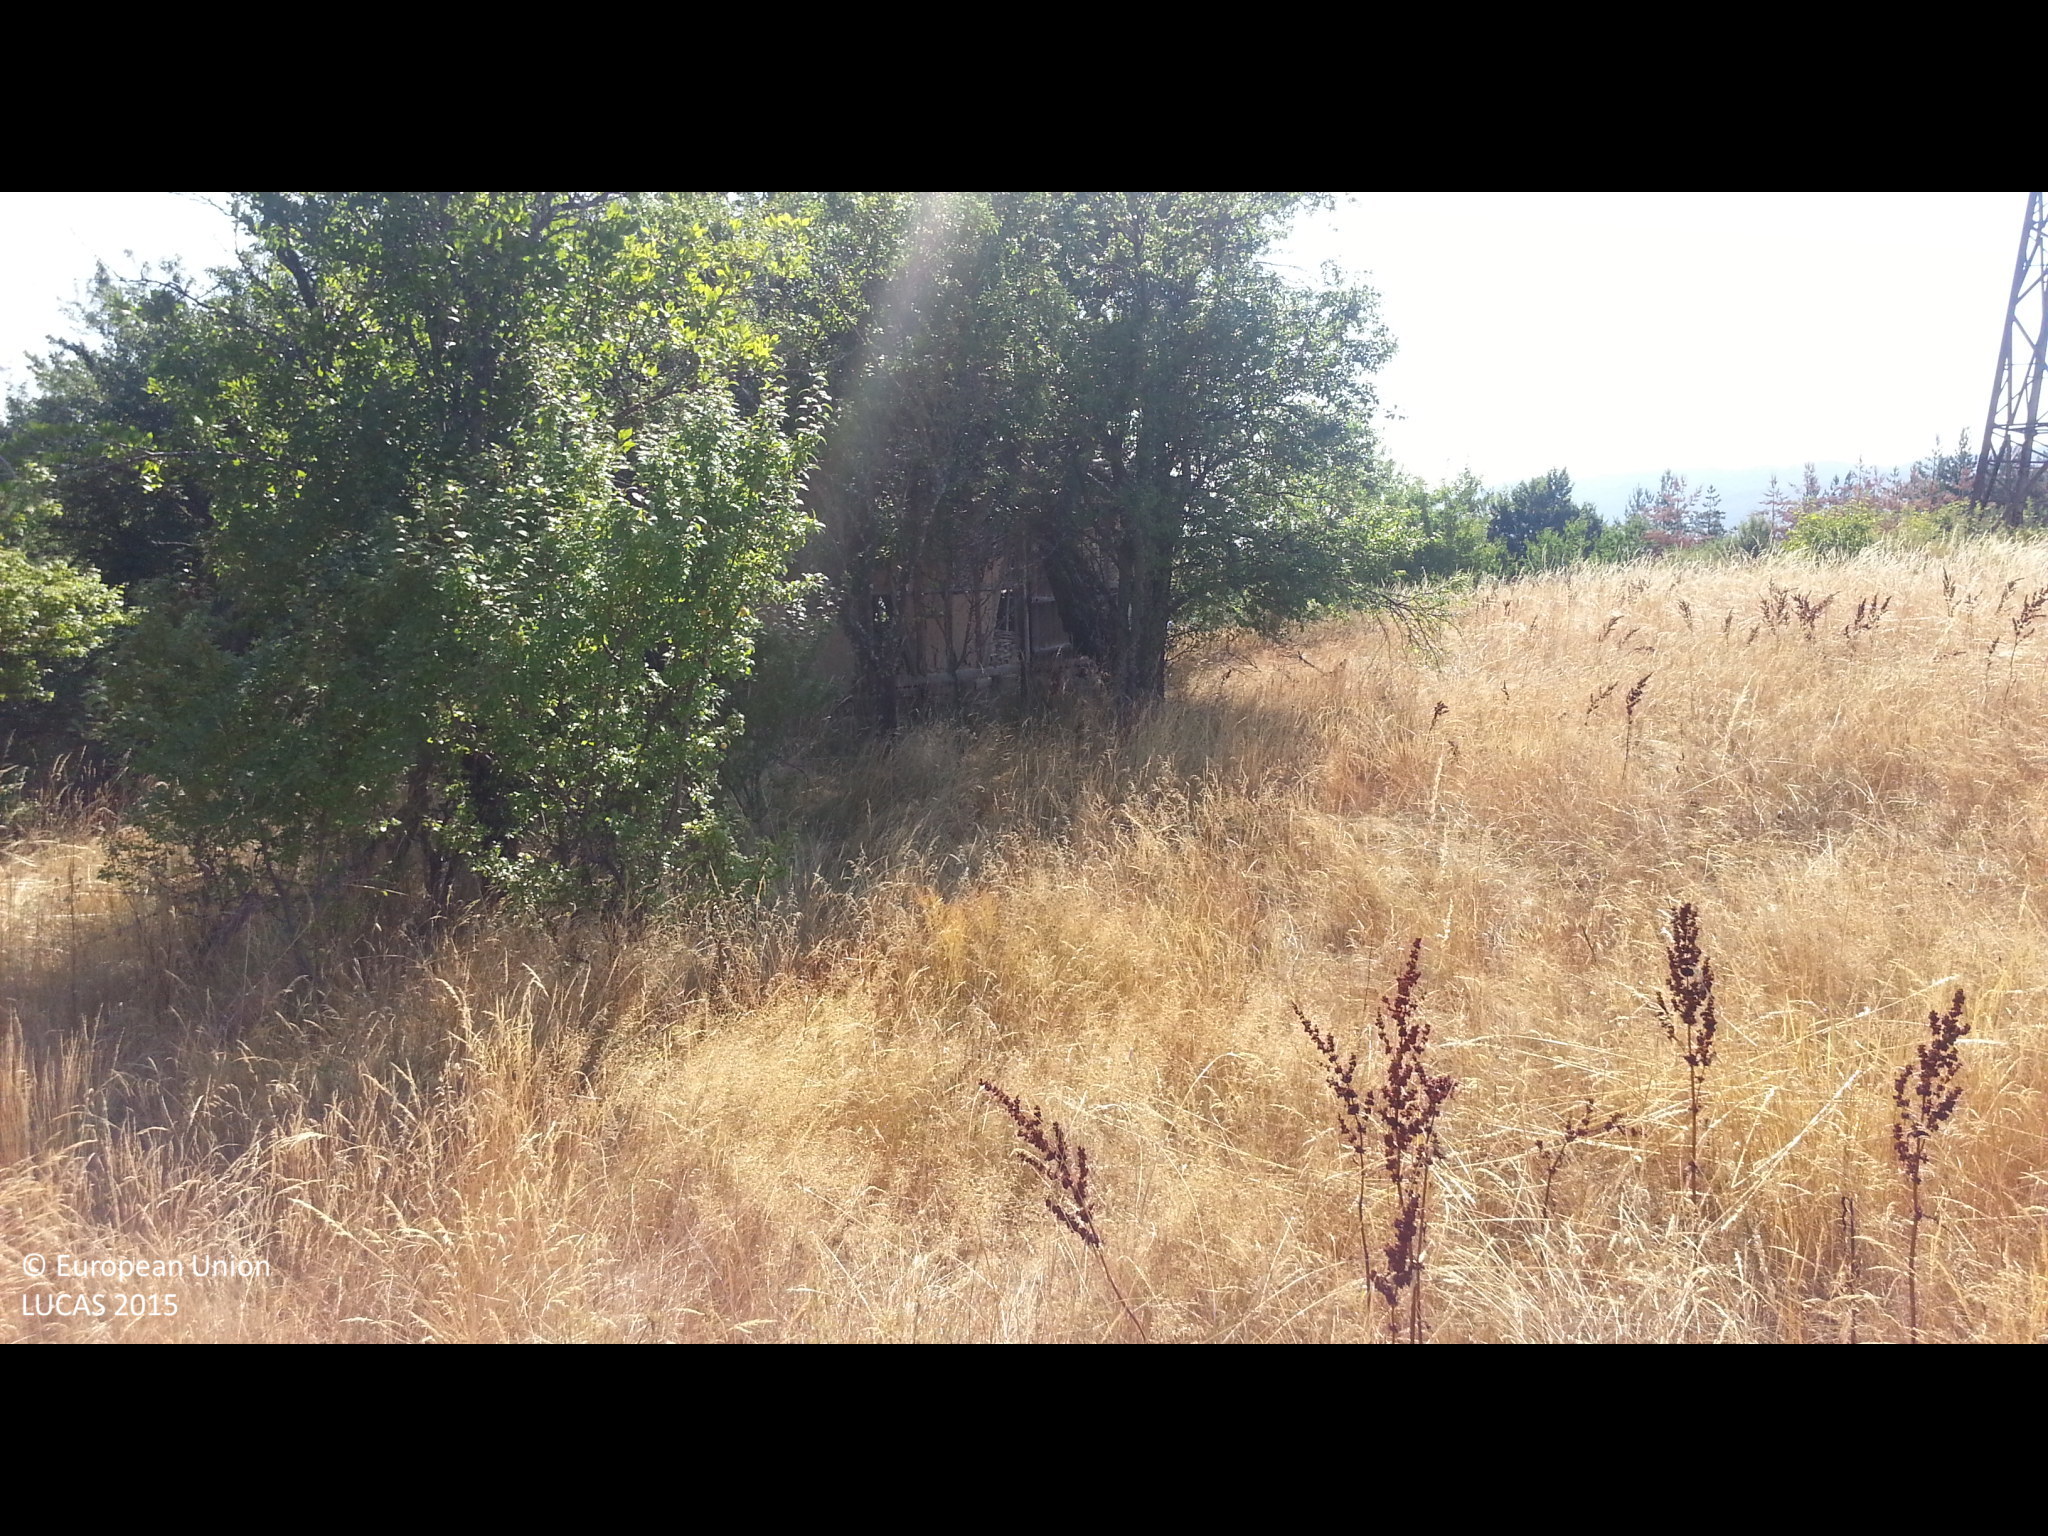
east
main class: Grassland
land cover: Grassland with sparse tree/shrub cover
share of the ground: > 75 %
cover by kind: herbaceous plants 90 %, broadleaved forest trees 5 %, shrubs 5 %
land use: Agriculture (excluding fallow land and kitchen gardens)
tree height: > 5 m
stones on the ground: < 10 %
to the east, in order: Grassland with sparse tree/shrub cover; Broadleaved woodland; Artificial constructions; Broadleaved woodland; Grassland with sparse tree/shrub cover; Electric lines; Grassland with sparse tree/shrub cover; Broadleaved woodland; Tracks; Broadleaved woodland
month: August
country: BG
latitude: 42.2694
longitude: 22.5685
